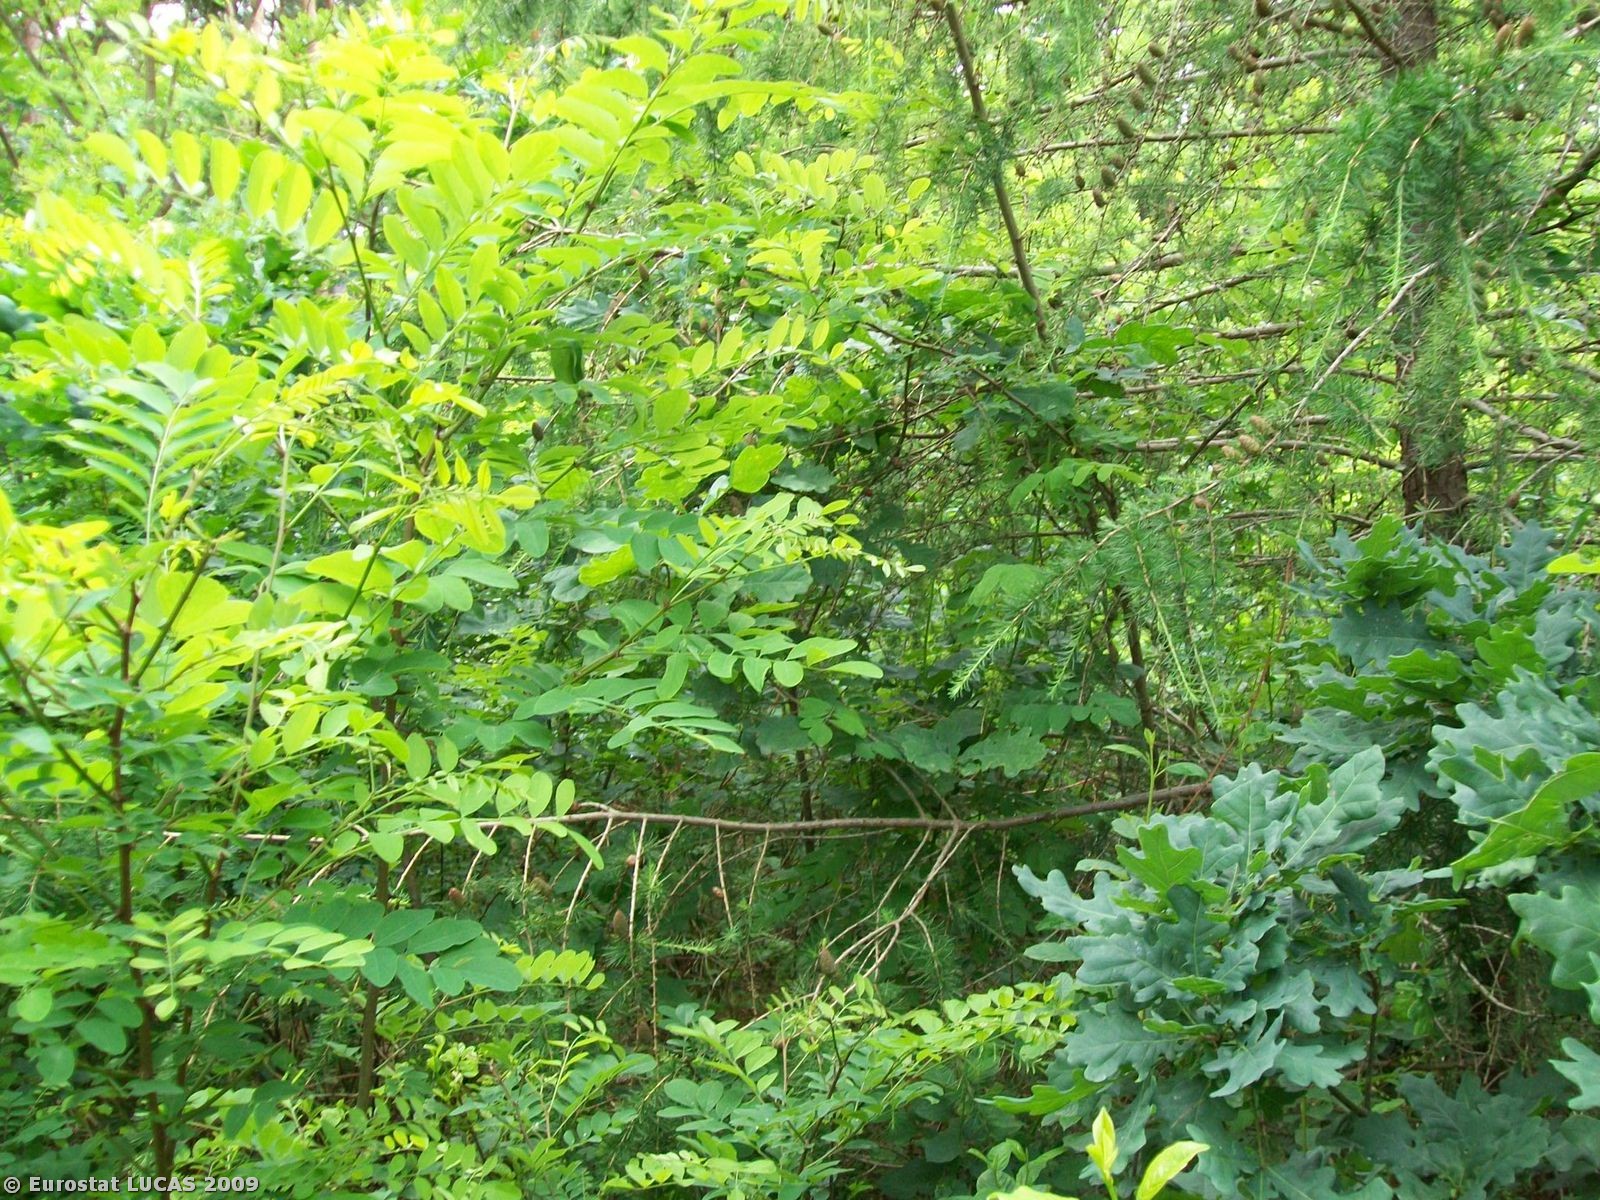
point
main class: Woodland
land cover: Mixed woodland
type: hemiboreal forest and nemoral coniferous forest and mixed broadleaved-coniferous forest
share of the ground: > 75 %
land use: Unused
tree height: > 5 m
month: June
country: PL
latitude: 51.9241
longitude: 15.1362
